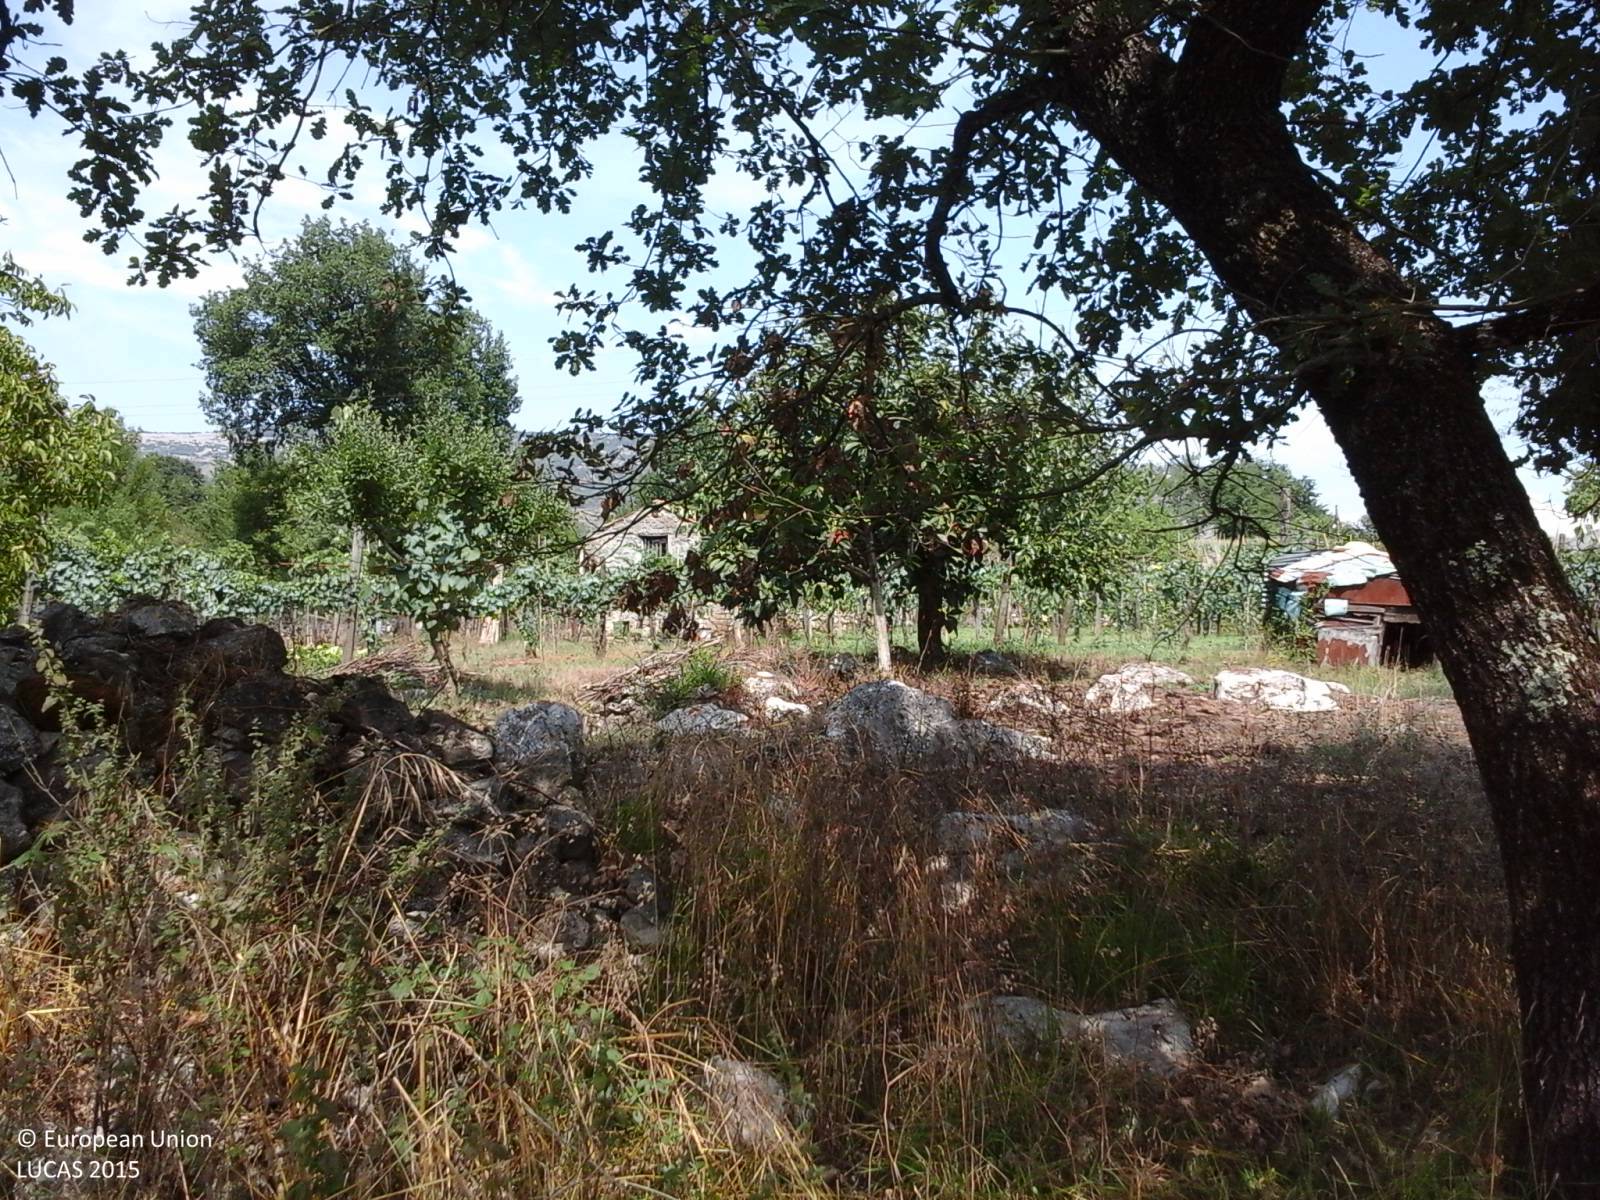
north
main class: Grassland
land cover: Grassland with sparse tree/shrub cover
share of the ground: > 75 %
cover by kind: herbaceous plants 75 %, unconsolidated bare surface 20 %, broadleaved forest trees 5 %
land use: Semi-natural and natural areas not in use
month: August
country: IT
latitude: 41.4782
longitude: 13.3282
